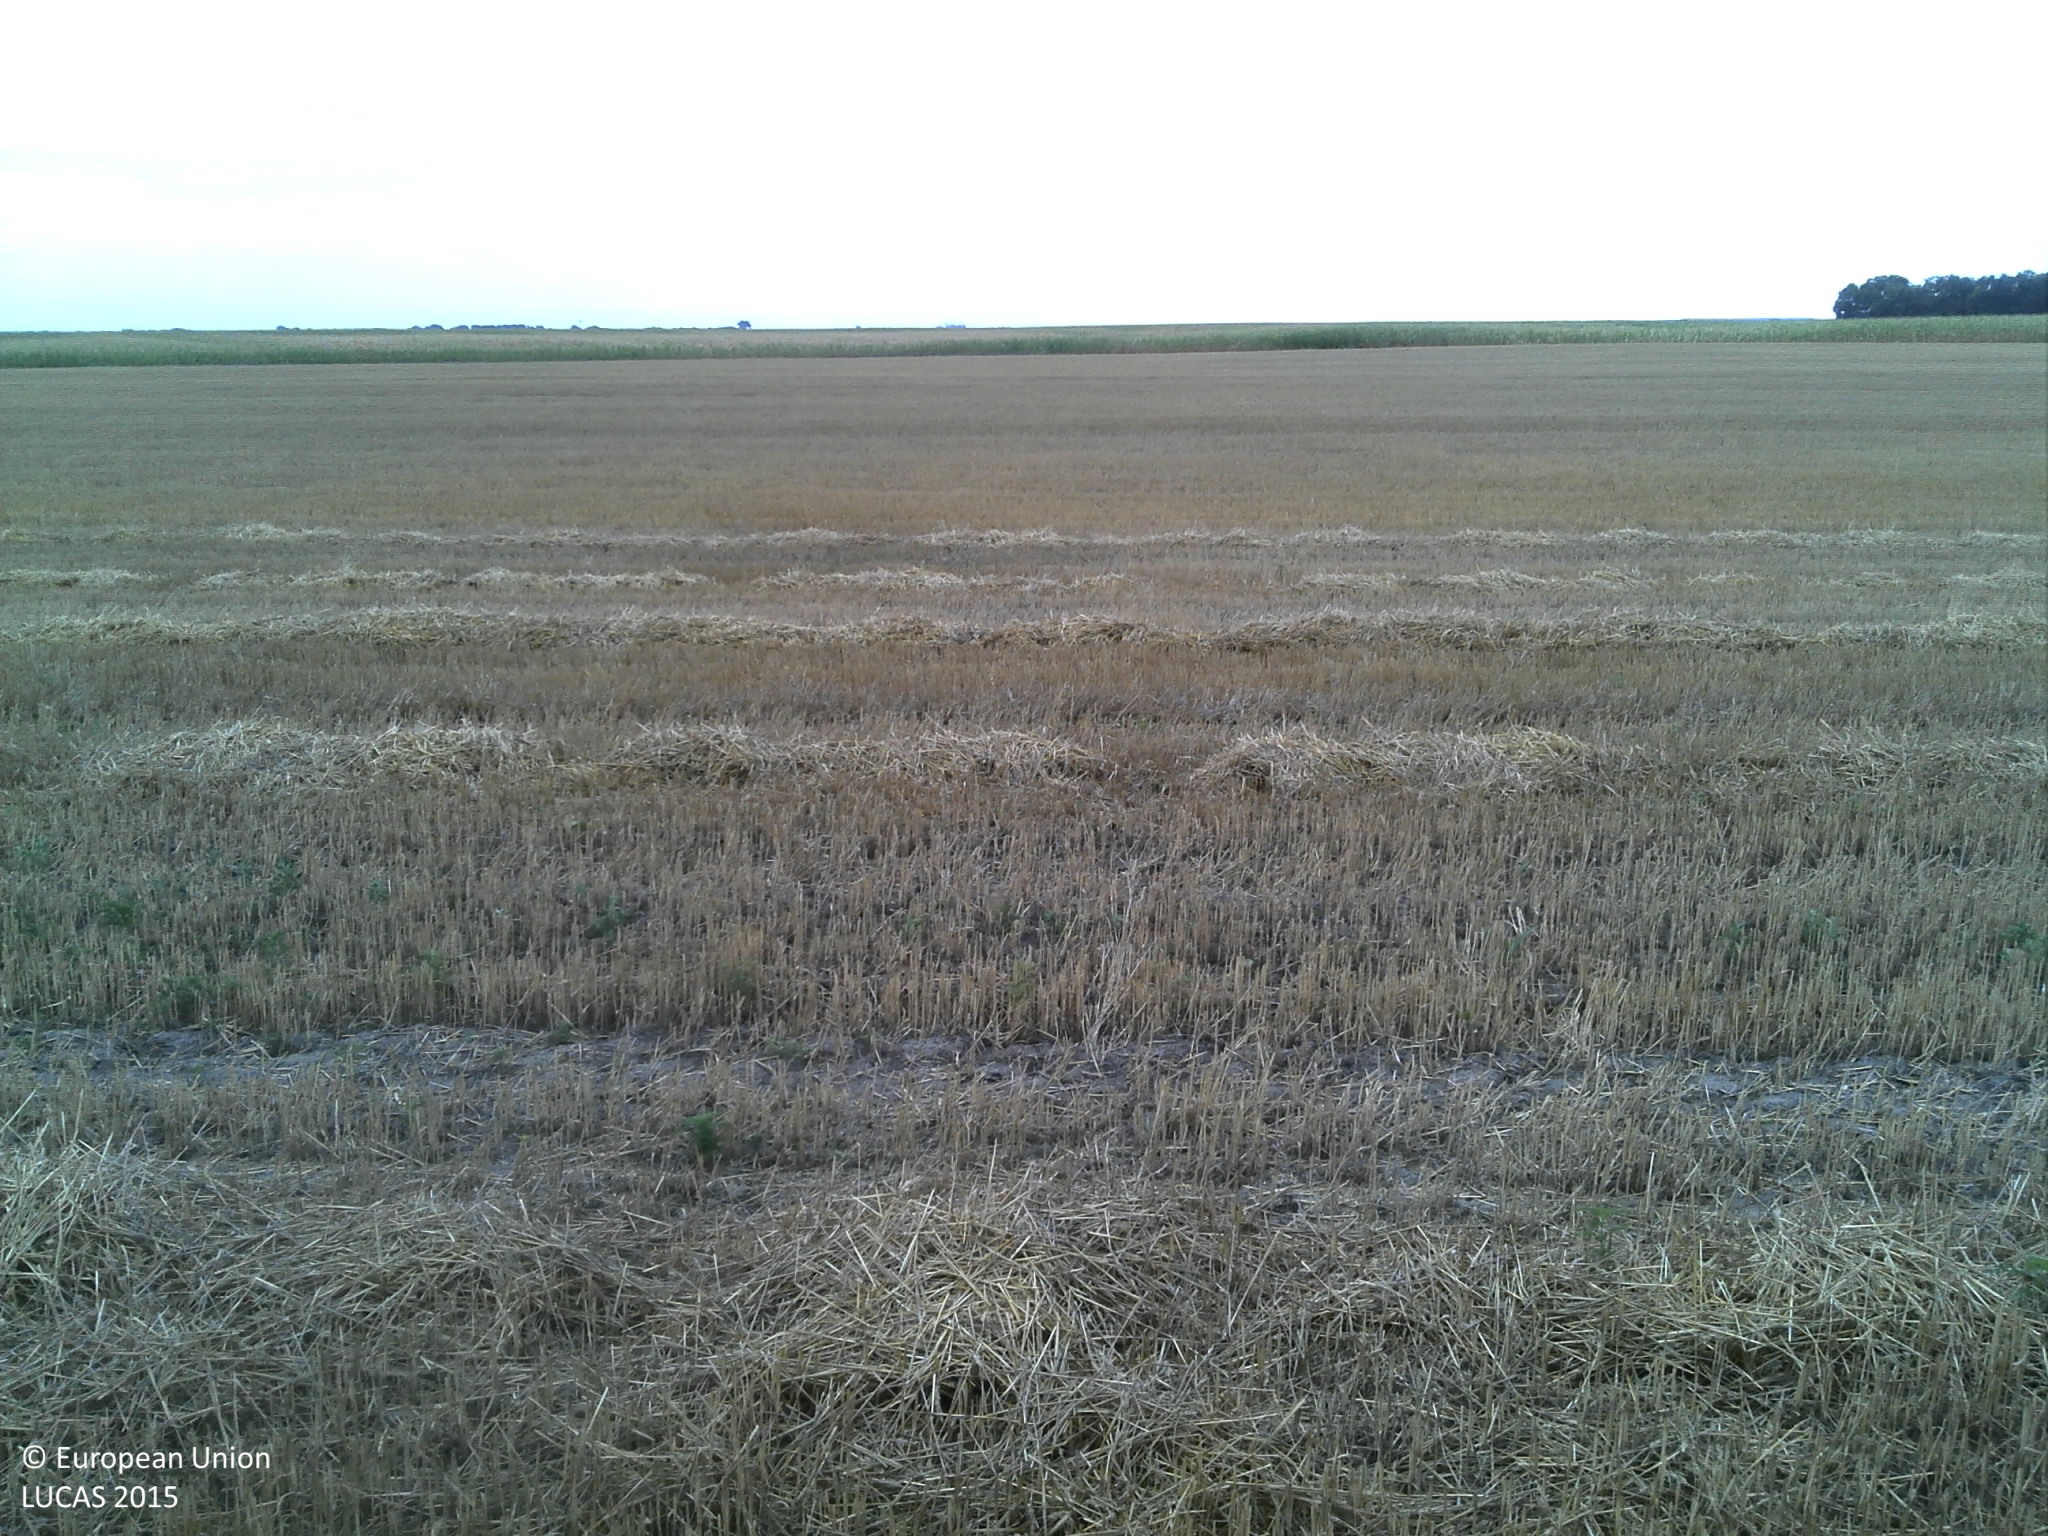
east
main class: Cropland
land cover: Common wheat
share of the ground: > 75 %
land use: Agriculture (excluding fallow land and kitchen gardens)
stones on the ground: < 10 %
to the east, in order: Common wheat; Tracks; Maize
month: July
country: HR
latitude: 45.6607
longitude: 18.5937
